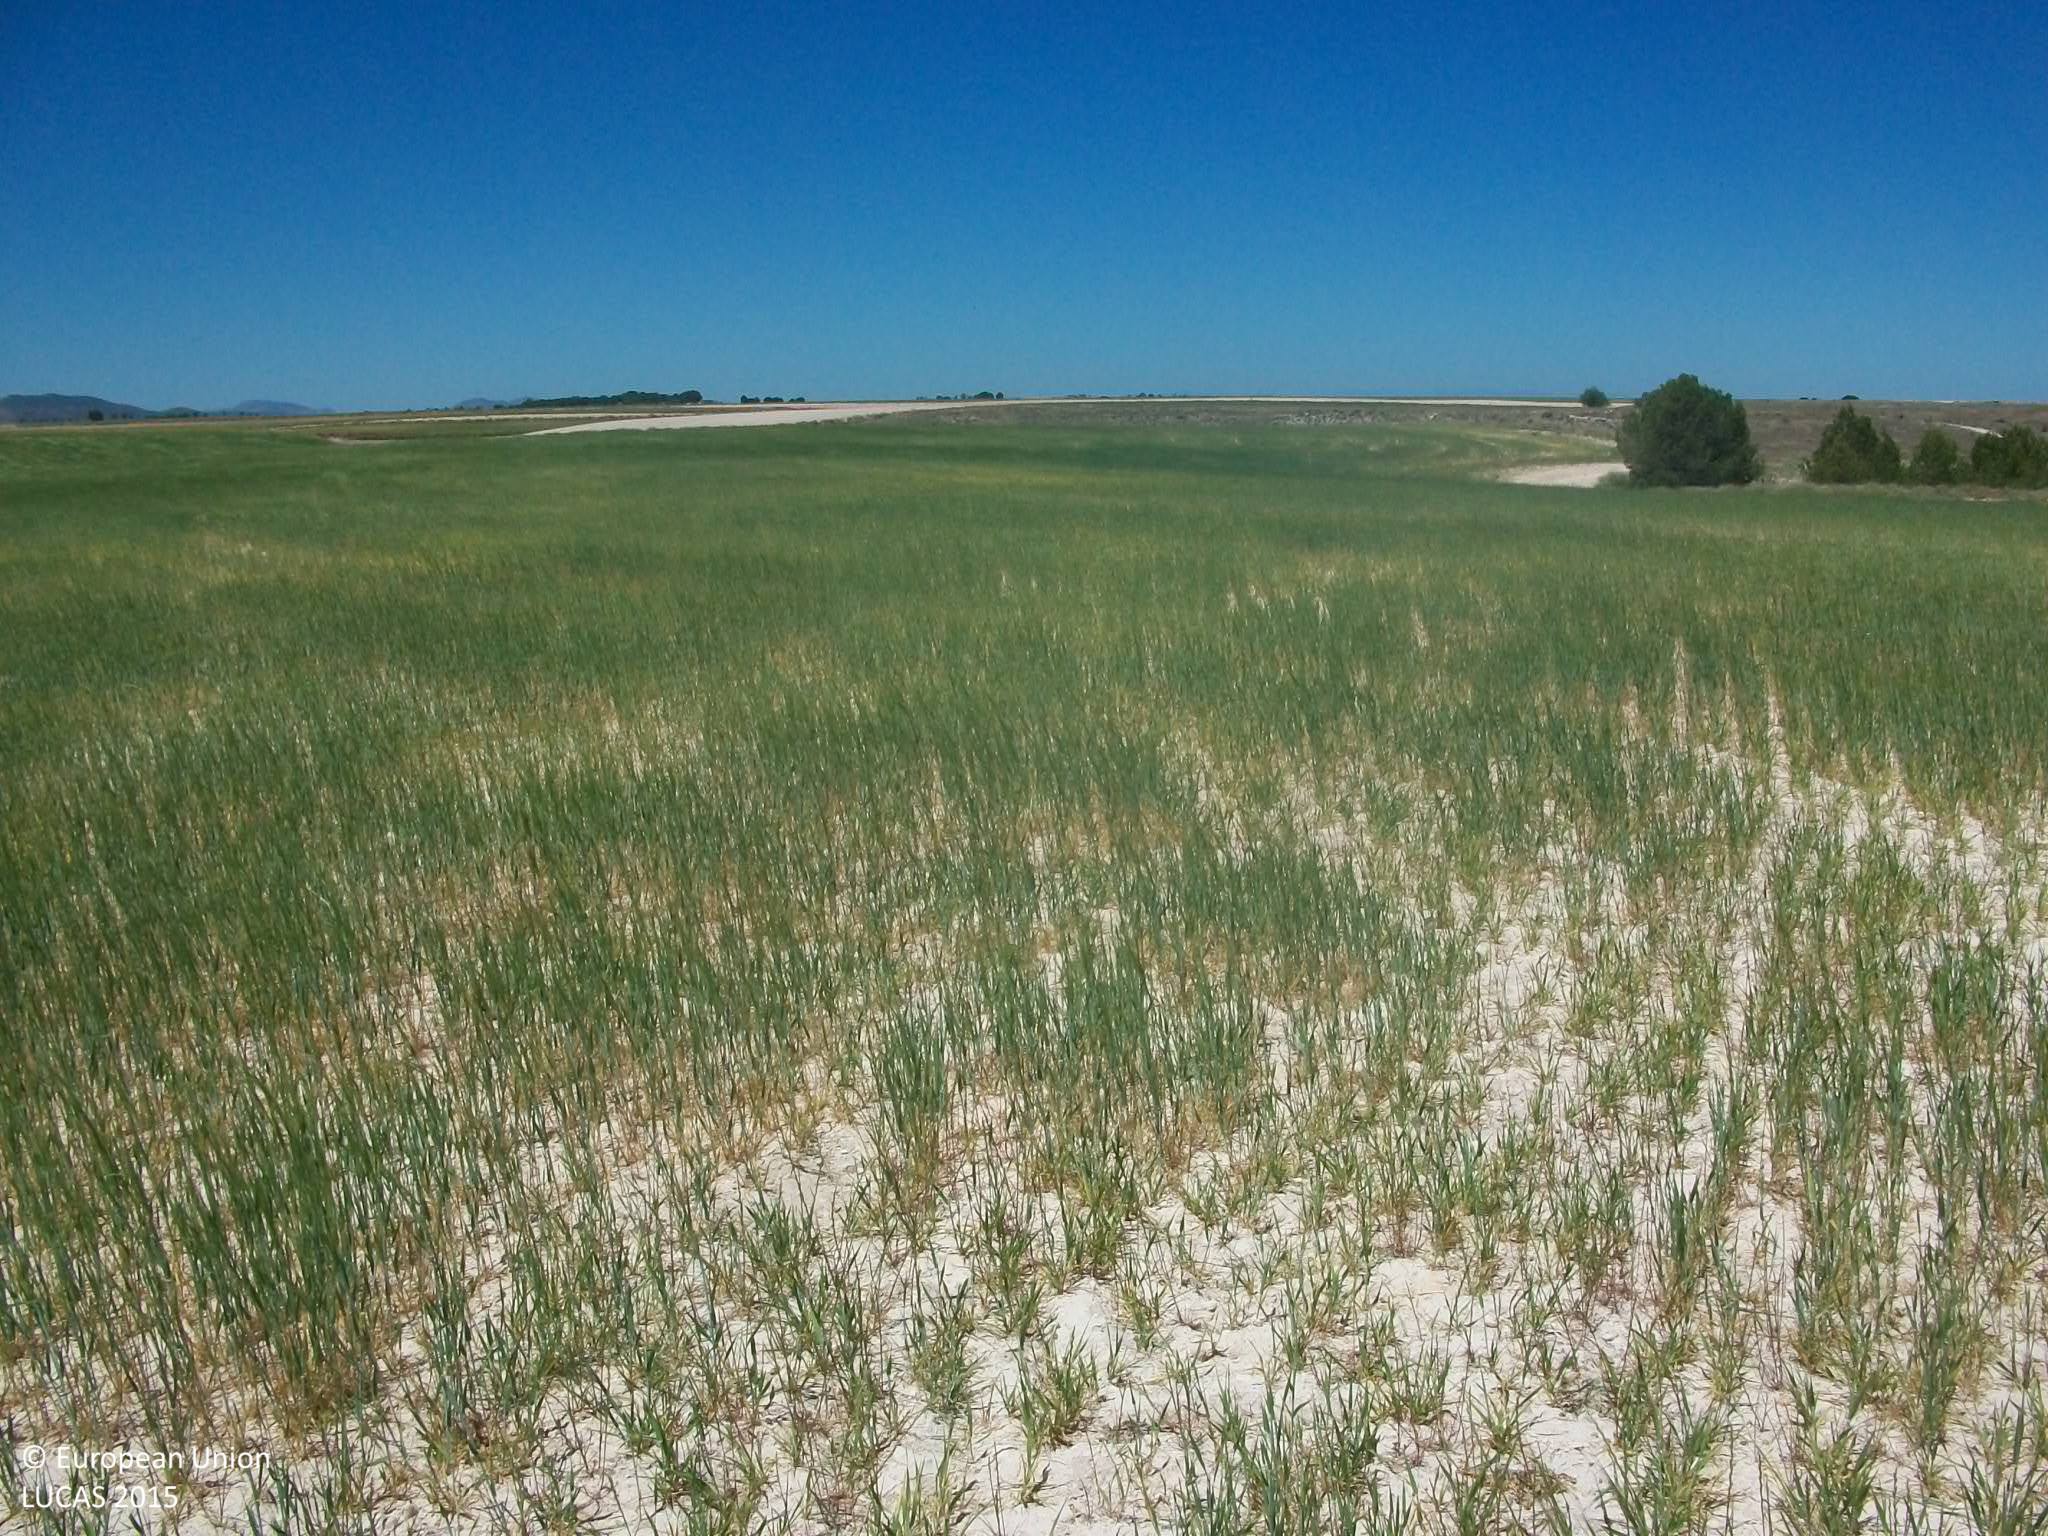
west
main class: Cropland
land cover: Common wheat
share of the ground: 50 - 75 %
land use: Agriculture (excluding fallow land and kitchen gardens)
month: May
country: ES
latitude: 39.6870
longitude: -3.5635
